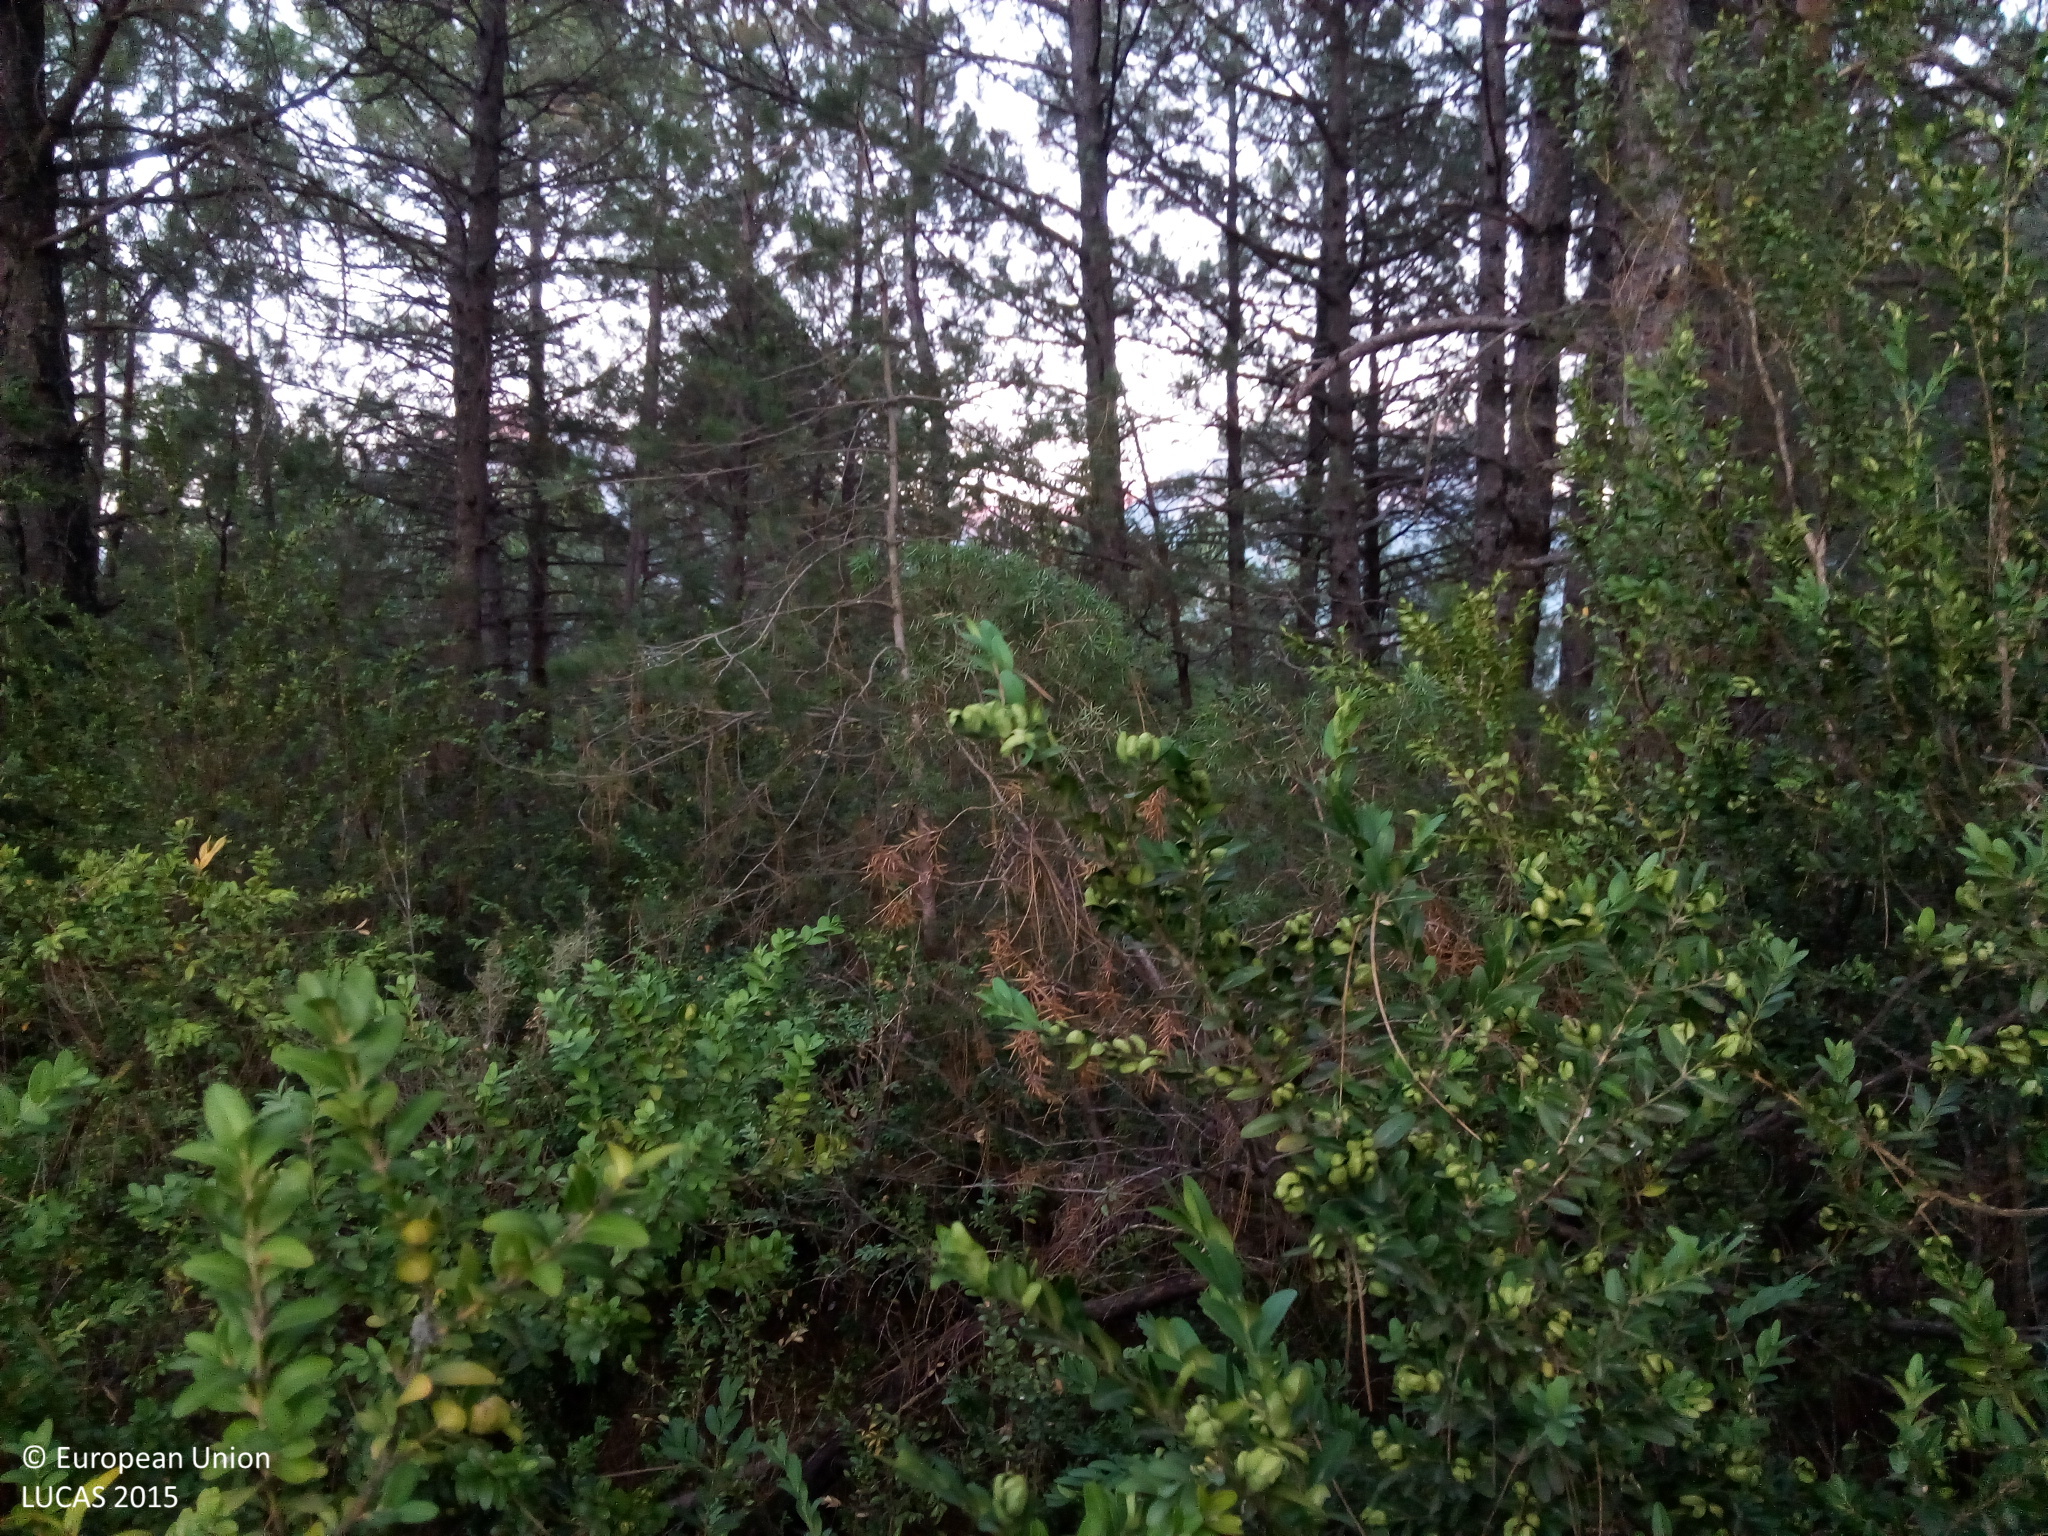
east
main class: Woodland
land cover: Pine dominated coniferous woodland
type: coniferous forest of the mediterranean region
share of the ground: > 75 %
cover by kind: coniferous forest trees 95 %, shrubs 5 %
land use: Forestry
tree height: > 5 m
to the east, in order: Pine dominated coniferous woodland; Paved roads, cycling and walking lanes; Pine dominated coniferous woodland
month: August
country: ES
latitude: 42.5164
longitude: 0.1311
